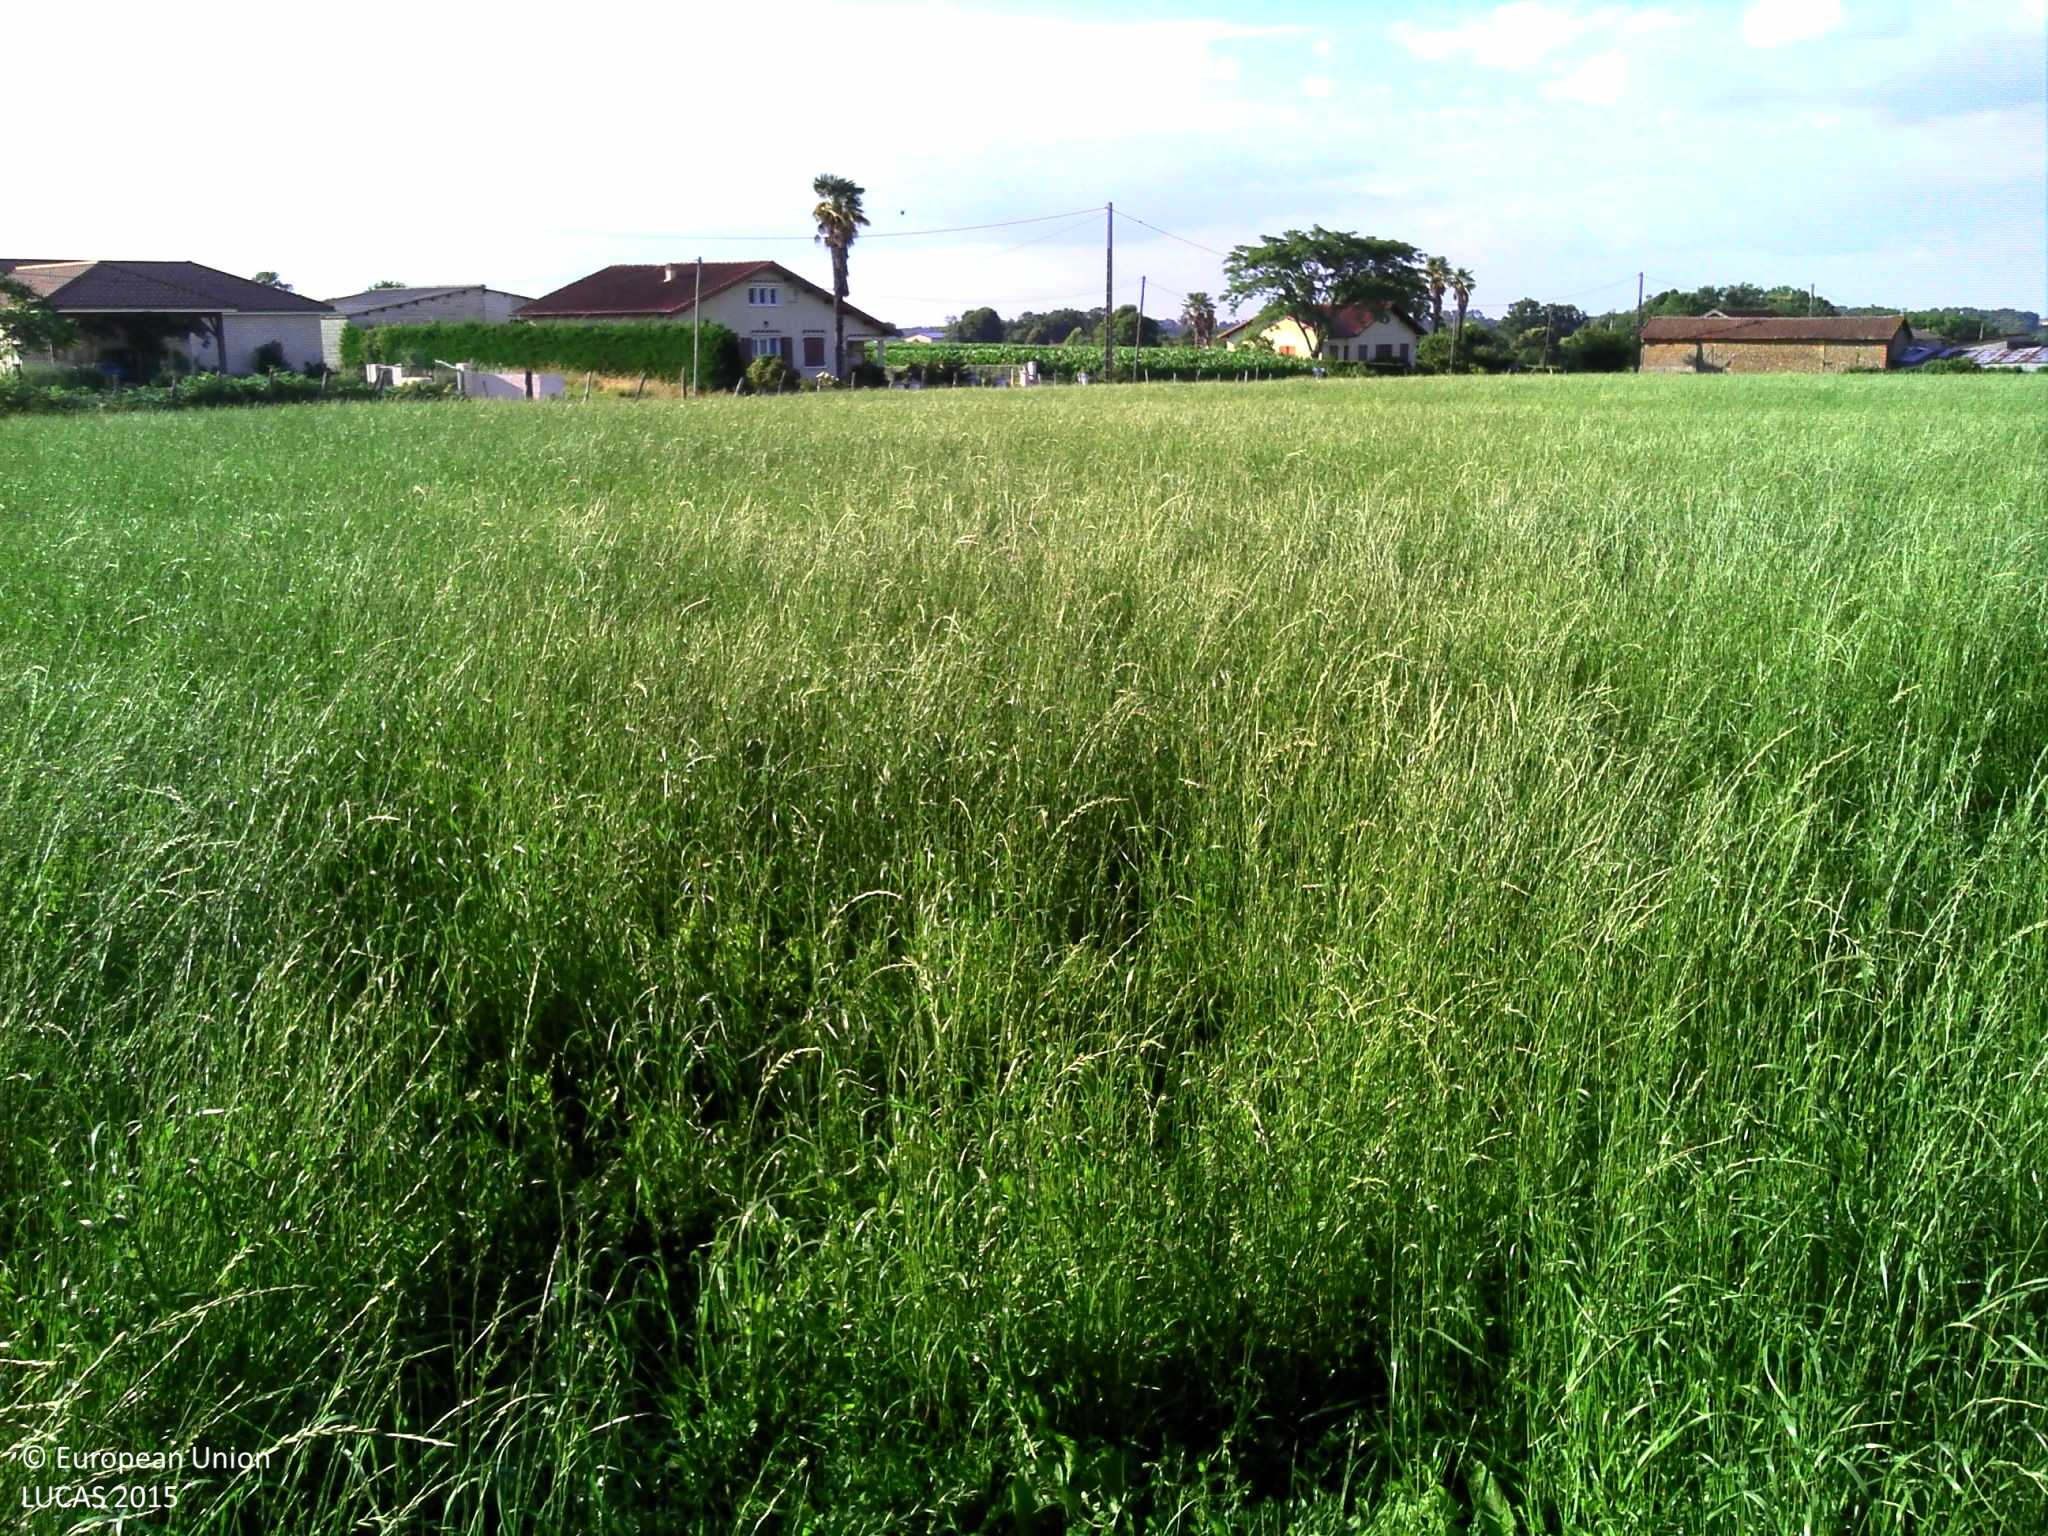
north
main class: Grassland
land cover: Grassland without tree/shrub cover
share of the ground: > 75 %
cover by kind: herbaceous plants 100 %
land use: Agriculture (excluding fallow land and kitchen gardens)
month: June
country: FR
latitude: 43.5877
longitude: -0.4254
